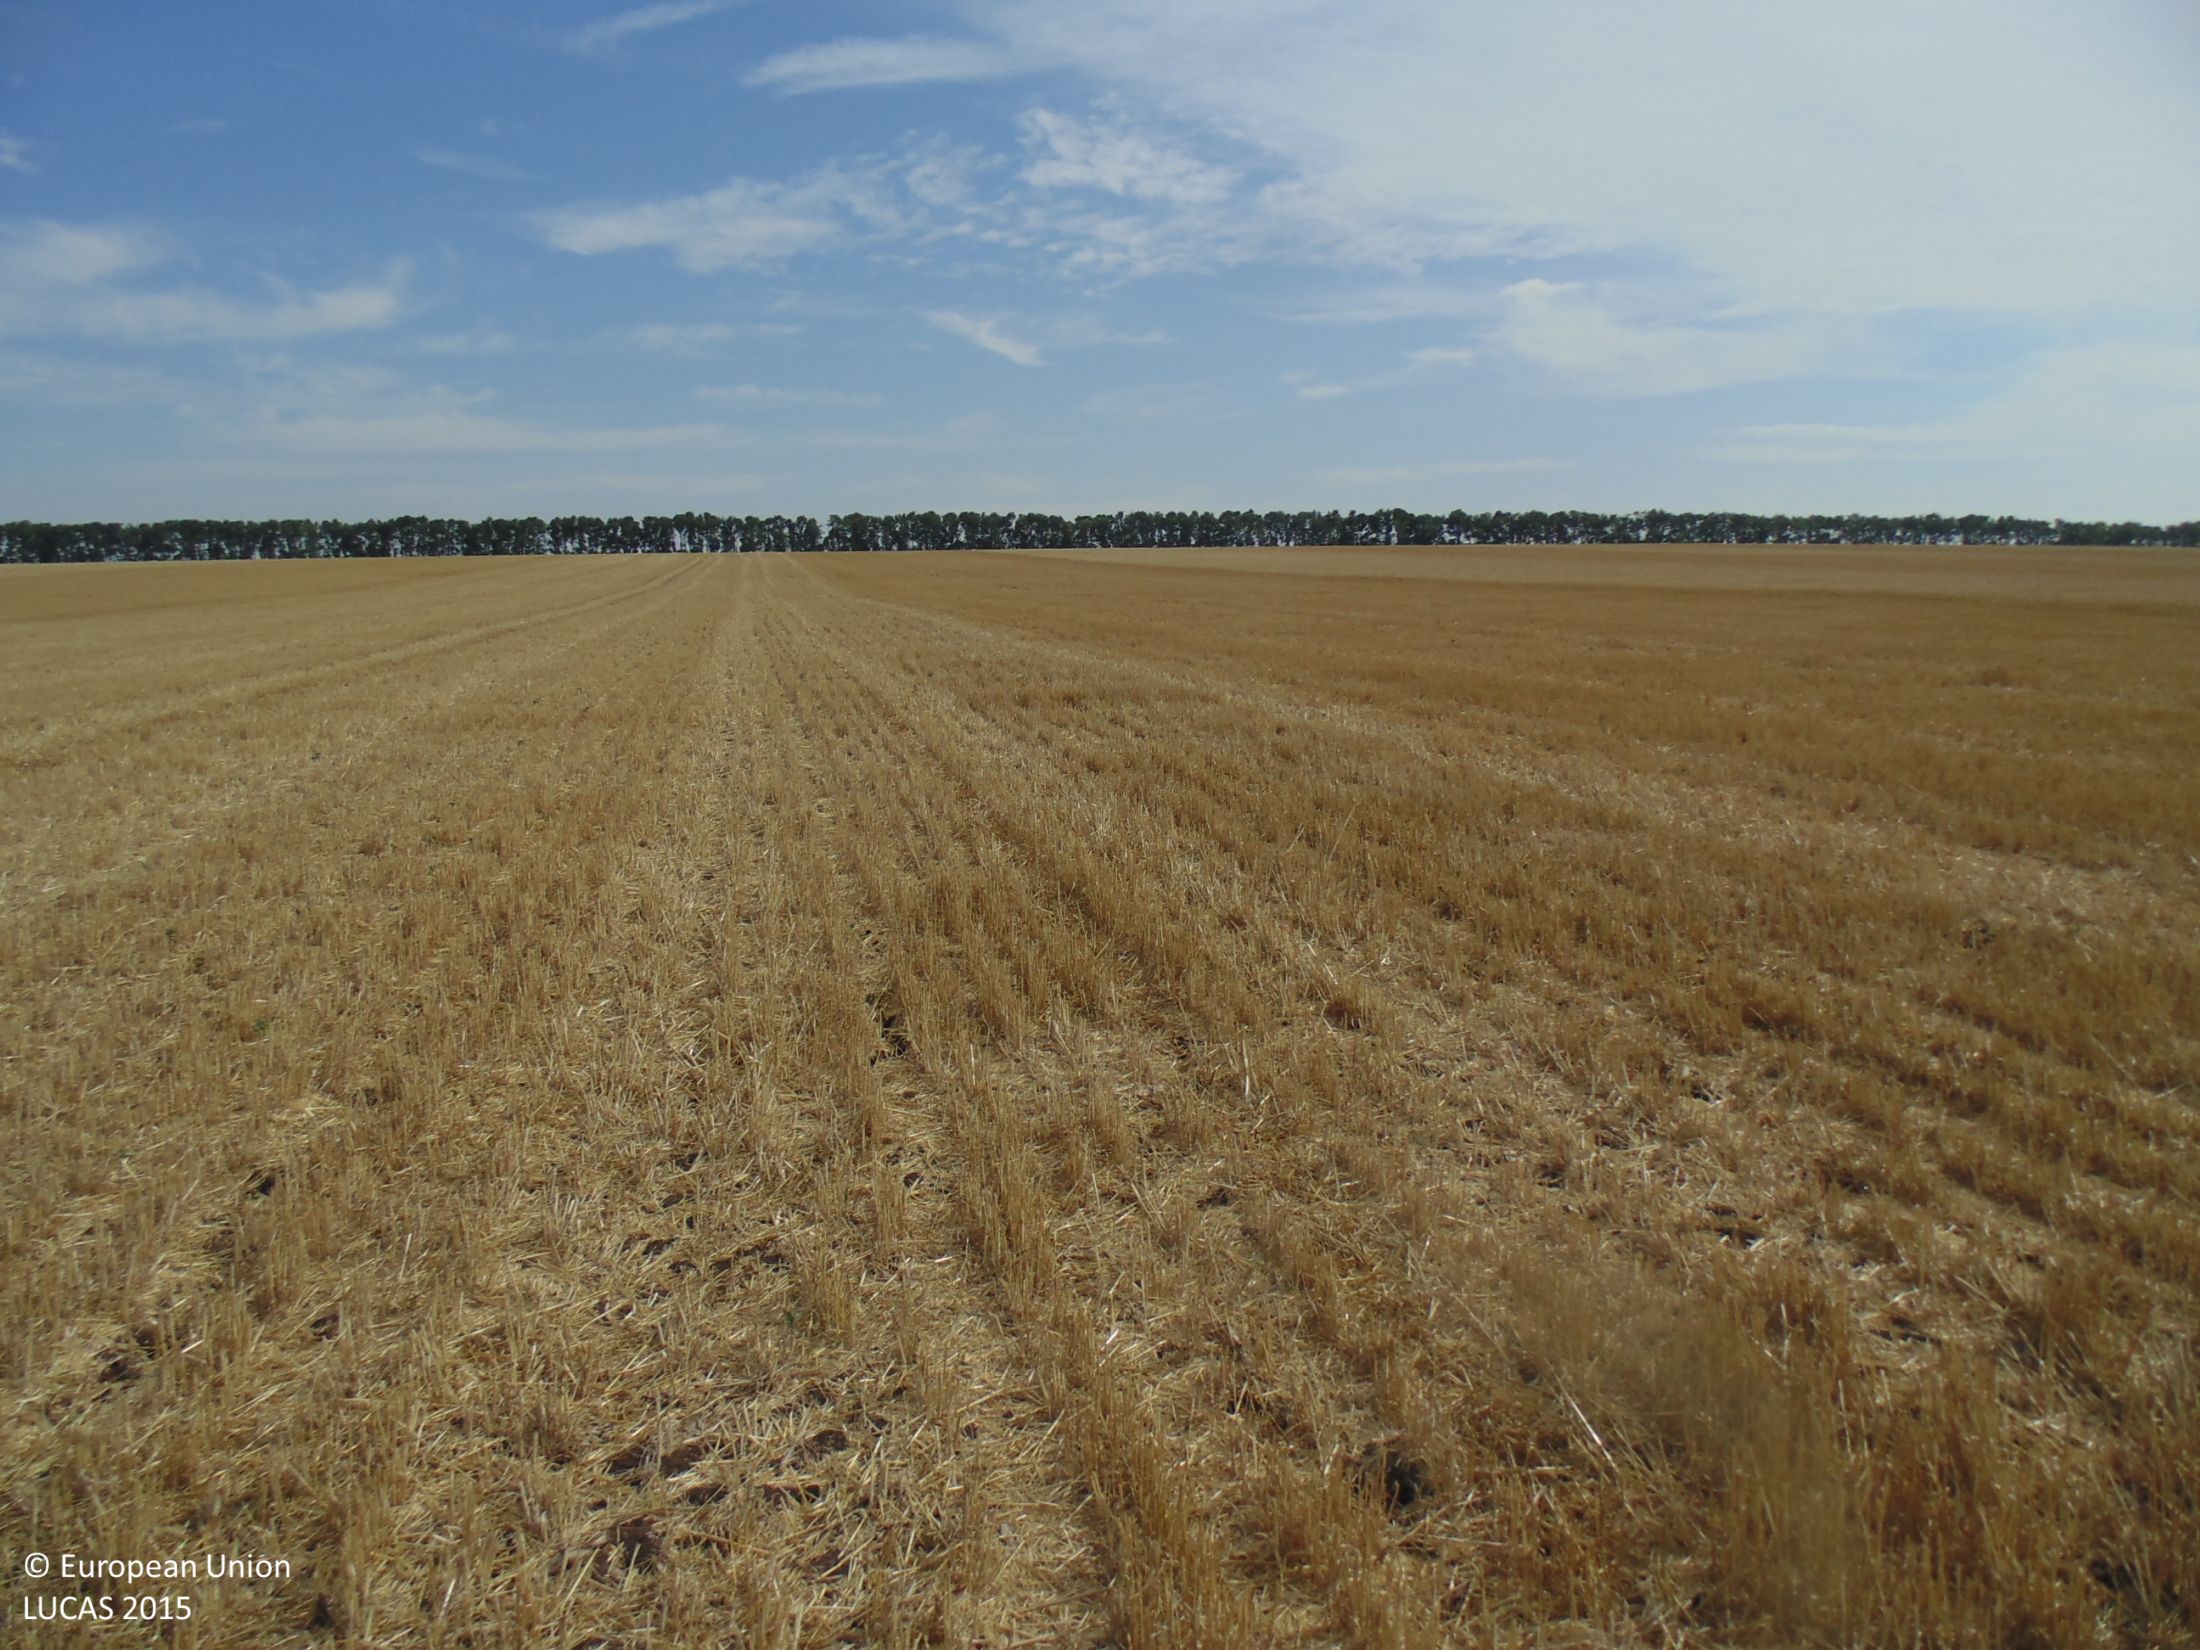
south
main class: Cropland
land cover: Common wheat
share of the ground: 25 - 50 %
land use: Agriculture (excluding fallow land and kitchen gardens)
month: August
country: BG
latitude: 43.6396
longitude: 28.3429
